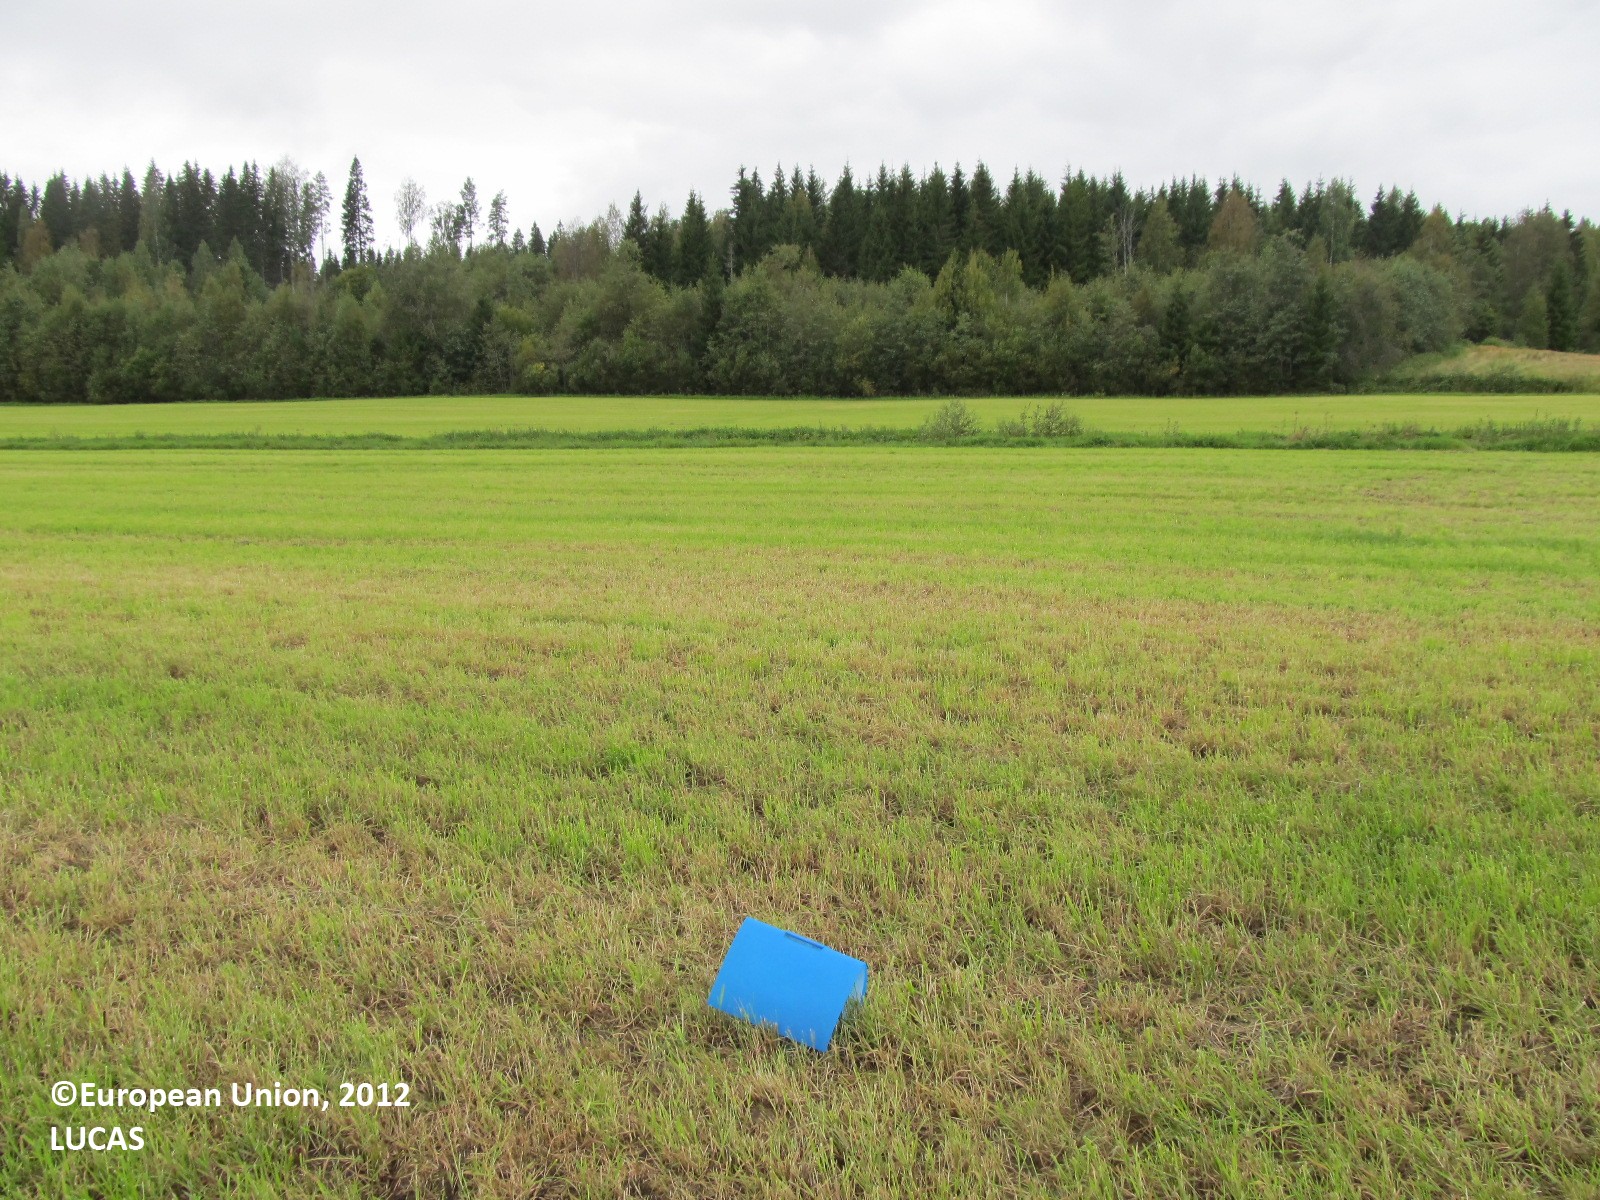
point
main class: Cropland
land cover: Temporary grasslands
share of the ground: 50 - 75 %
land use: Agriculture (excluding fallow land and kitchen gardens)
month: August
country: FI
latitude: 63.1757
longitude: 27.6232
